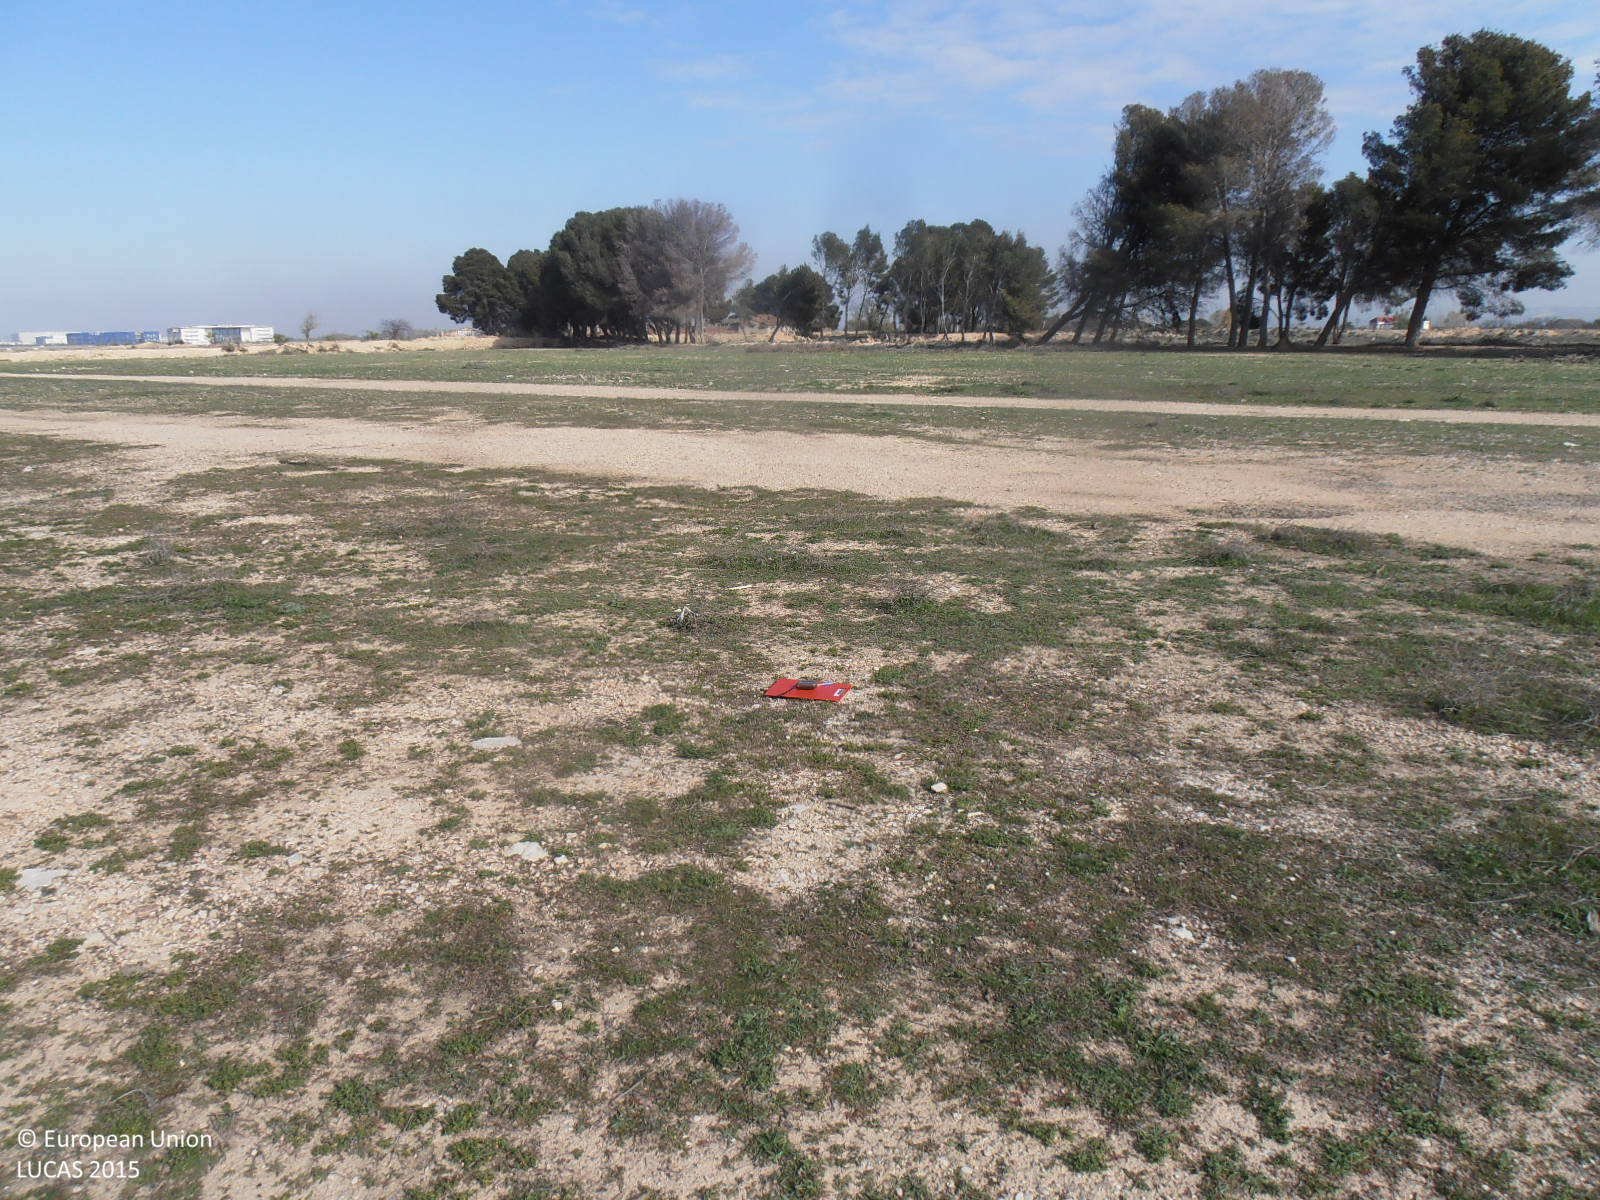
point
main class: Grassland
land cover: Grassland without tree/shrub cover
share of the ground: > 75 %
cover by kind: herbaceous plants 95 %, shrubs 5 %
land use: Abandoned areas
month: April
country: ES
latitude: 41.6386
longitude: -0.9589
